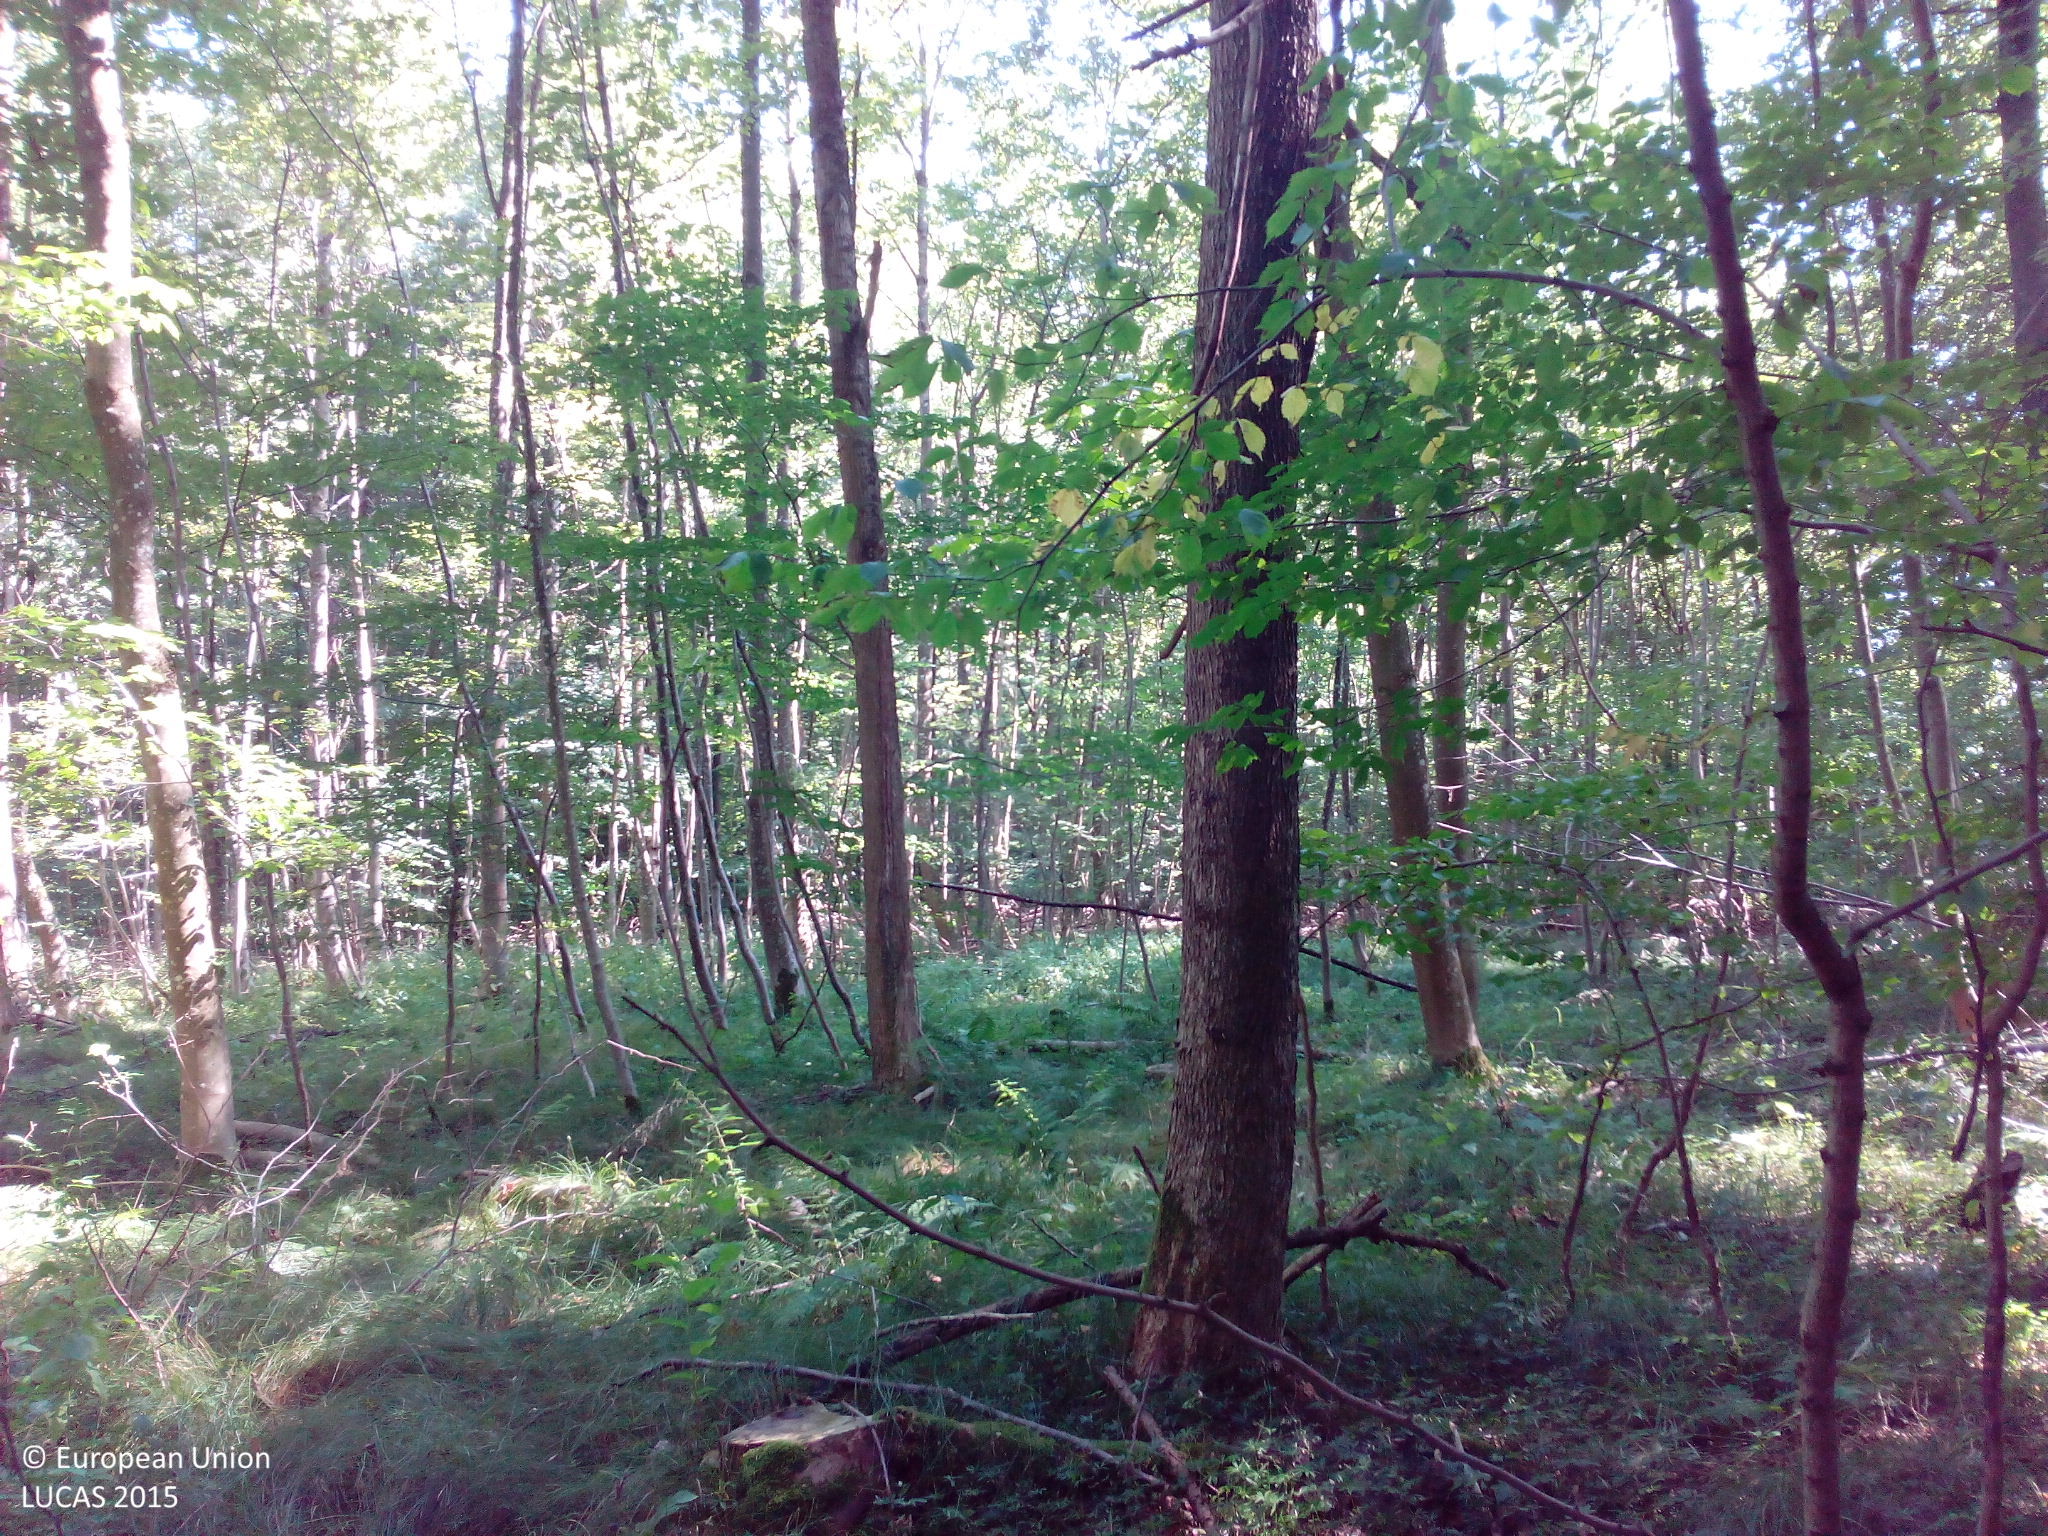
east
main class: Woodland
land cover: Broadleaved woodland
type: mesophytic deciduous forest
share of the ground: > 75 %
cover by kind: broadleaved forest trees 90 %, shrubs 5 %, unconsolidated bare surface 5 %
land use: Forestry
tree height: > 5 m
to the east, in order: Broadleaved woodland; Tracks; Electric lines; Broadleaved woodland; Spruce dominated coniferous woodland; Broadleaved woodland; Grassland without tree/shrub cover; Tracks; Grassland without tree/shrub cover
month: August
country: DE
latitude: 48.6551
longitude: 10.2578
